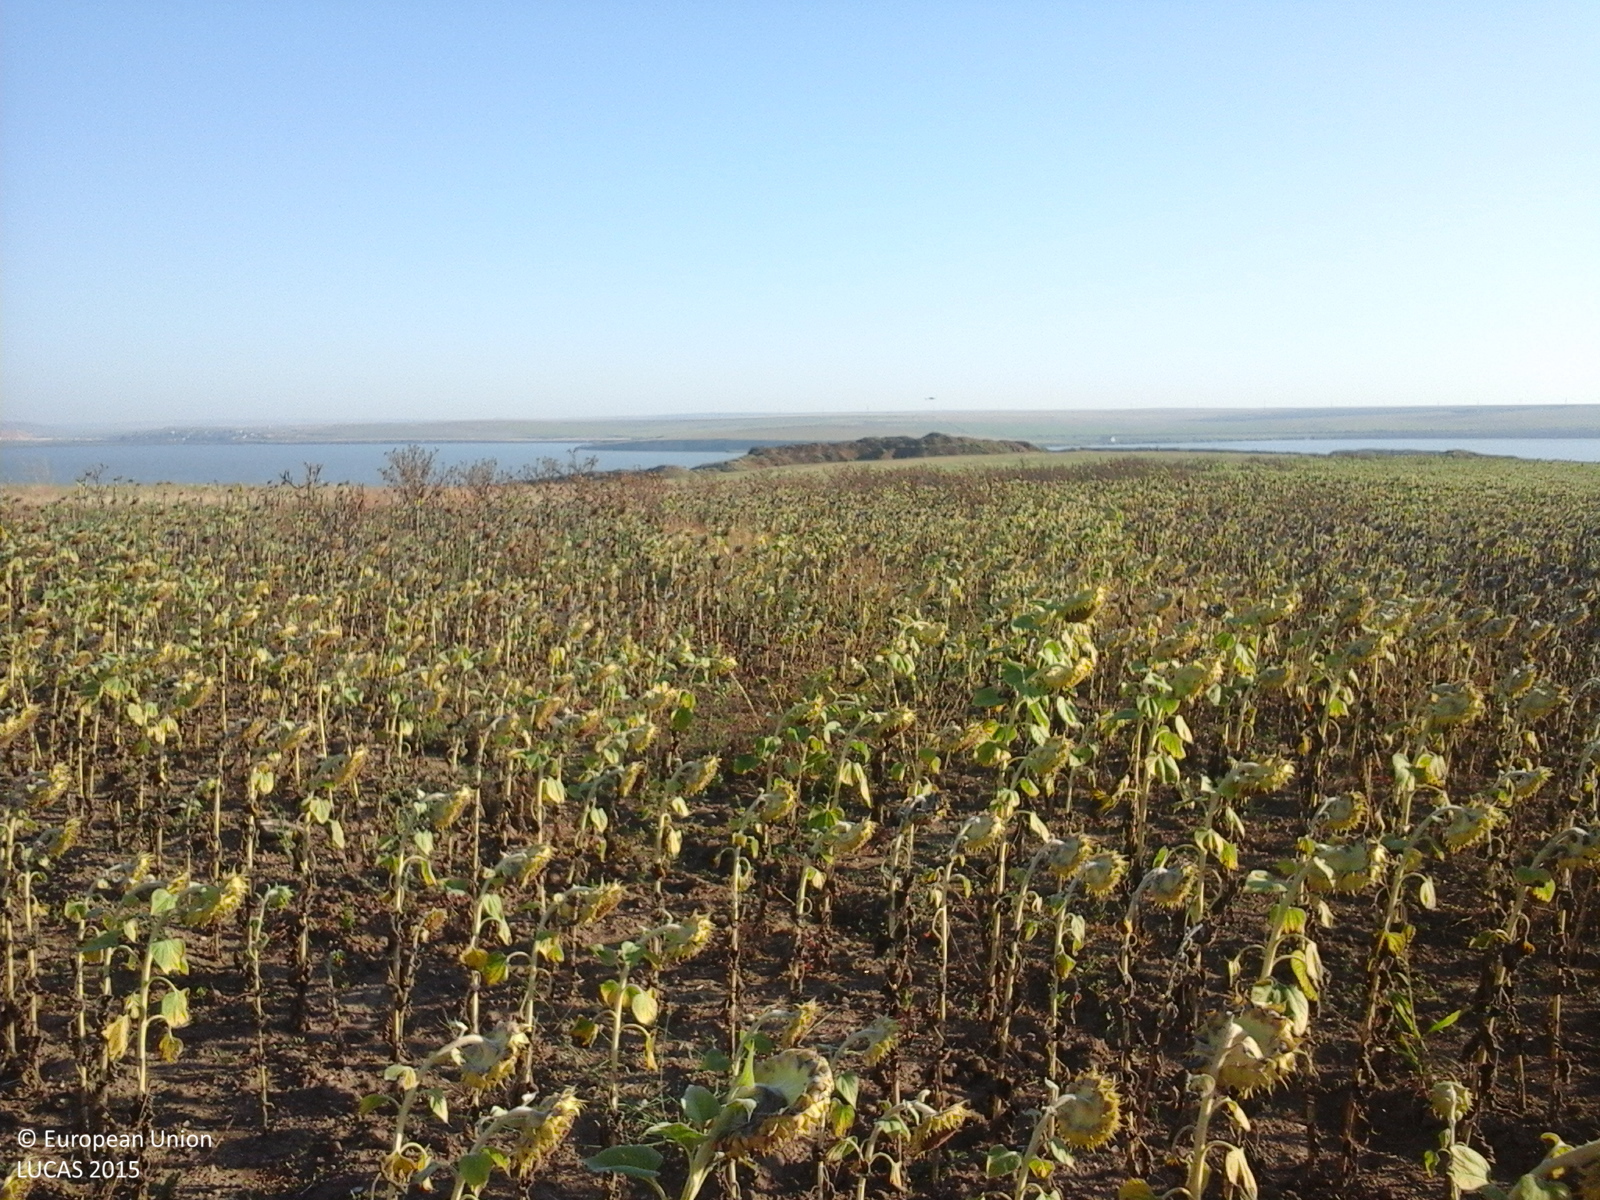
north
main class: Cropland
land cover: Sunflower
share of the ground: > 75 %
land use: Agriculture (excluding fallow land and kitchen gardens)
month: August
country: RO
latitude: 44.3538
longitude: 28.5790
